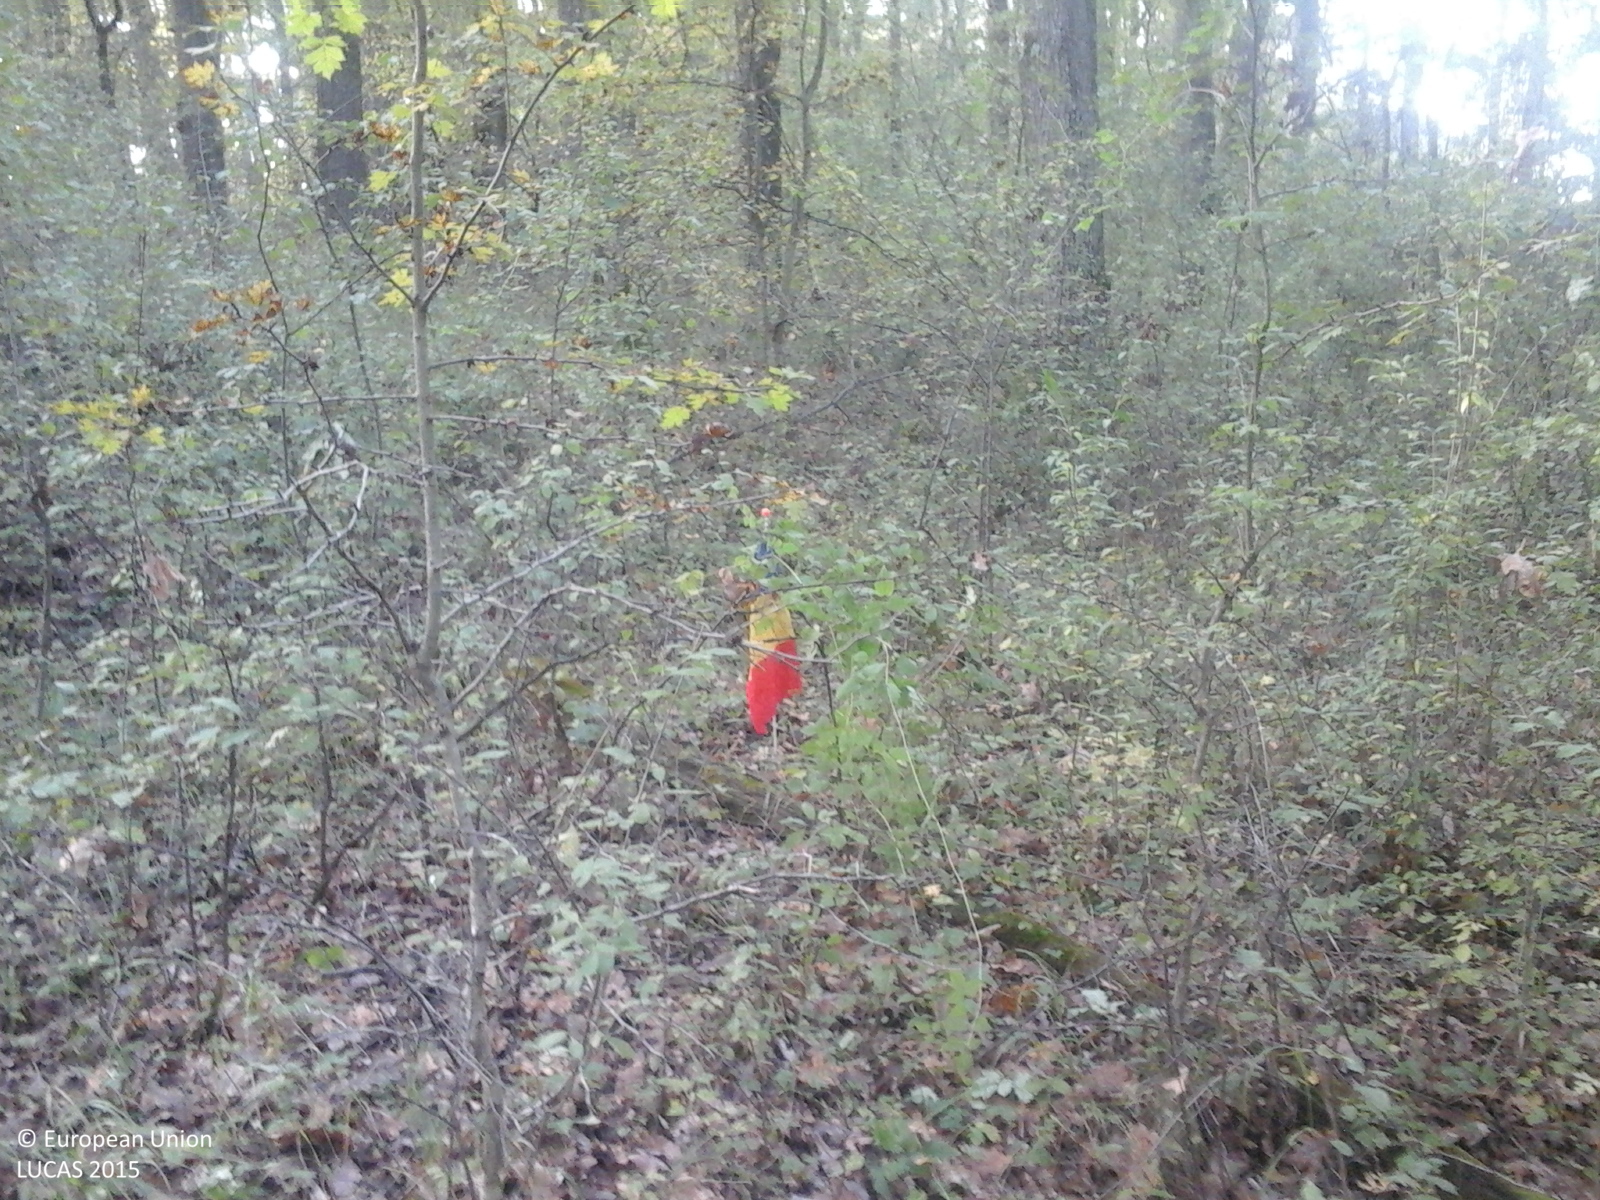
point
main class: Woodland
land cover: Broadleaved woodland
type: acidophilous oak and oak-birch forest
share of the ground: > 75 %
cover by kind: broadleaved forest trees 100 %
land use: Forestry
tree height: > 5 m
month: October
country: RO
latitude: 45.8793
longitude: 24.9474
